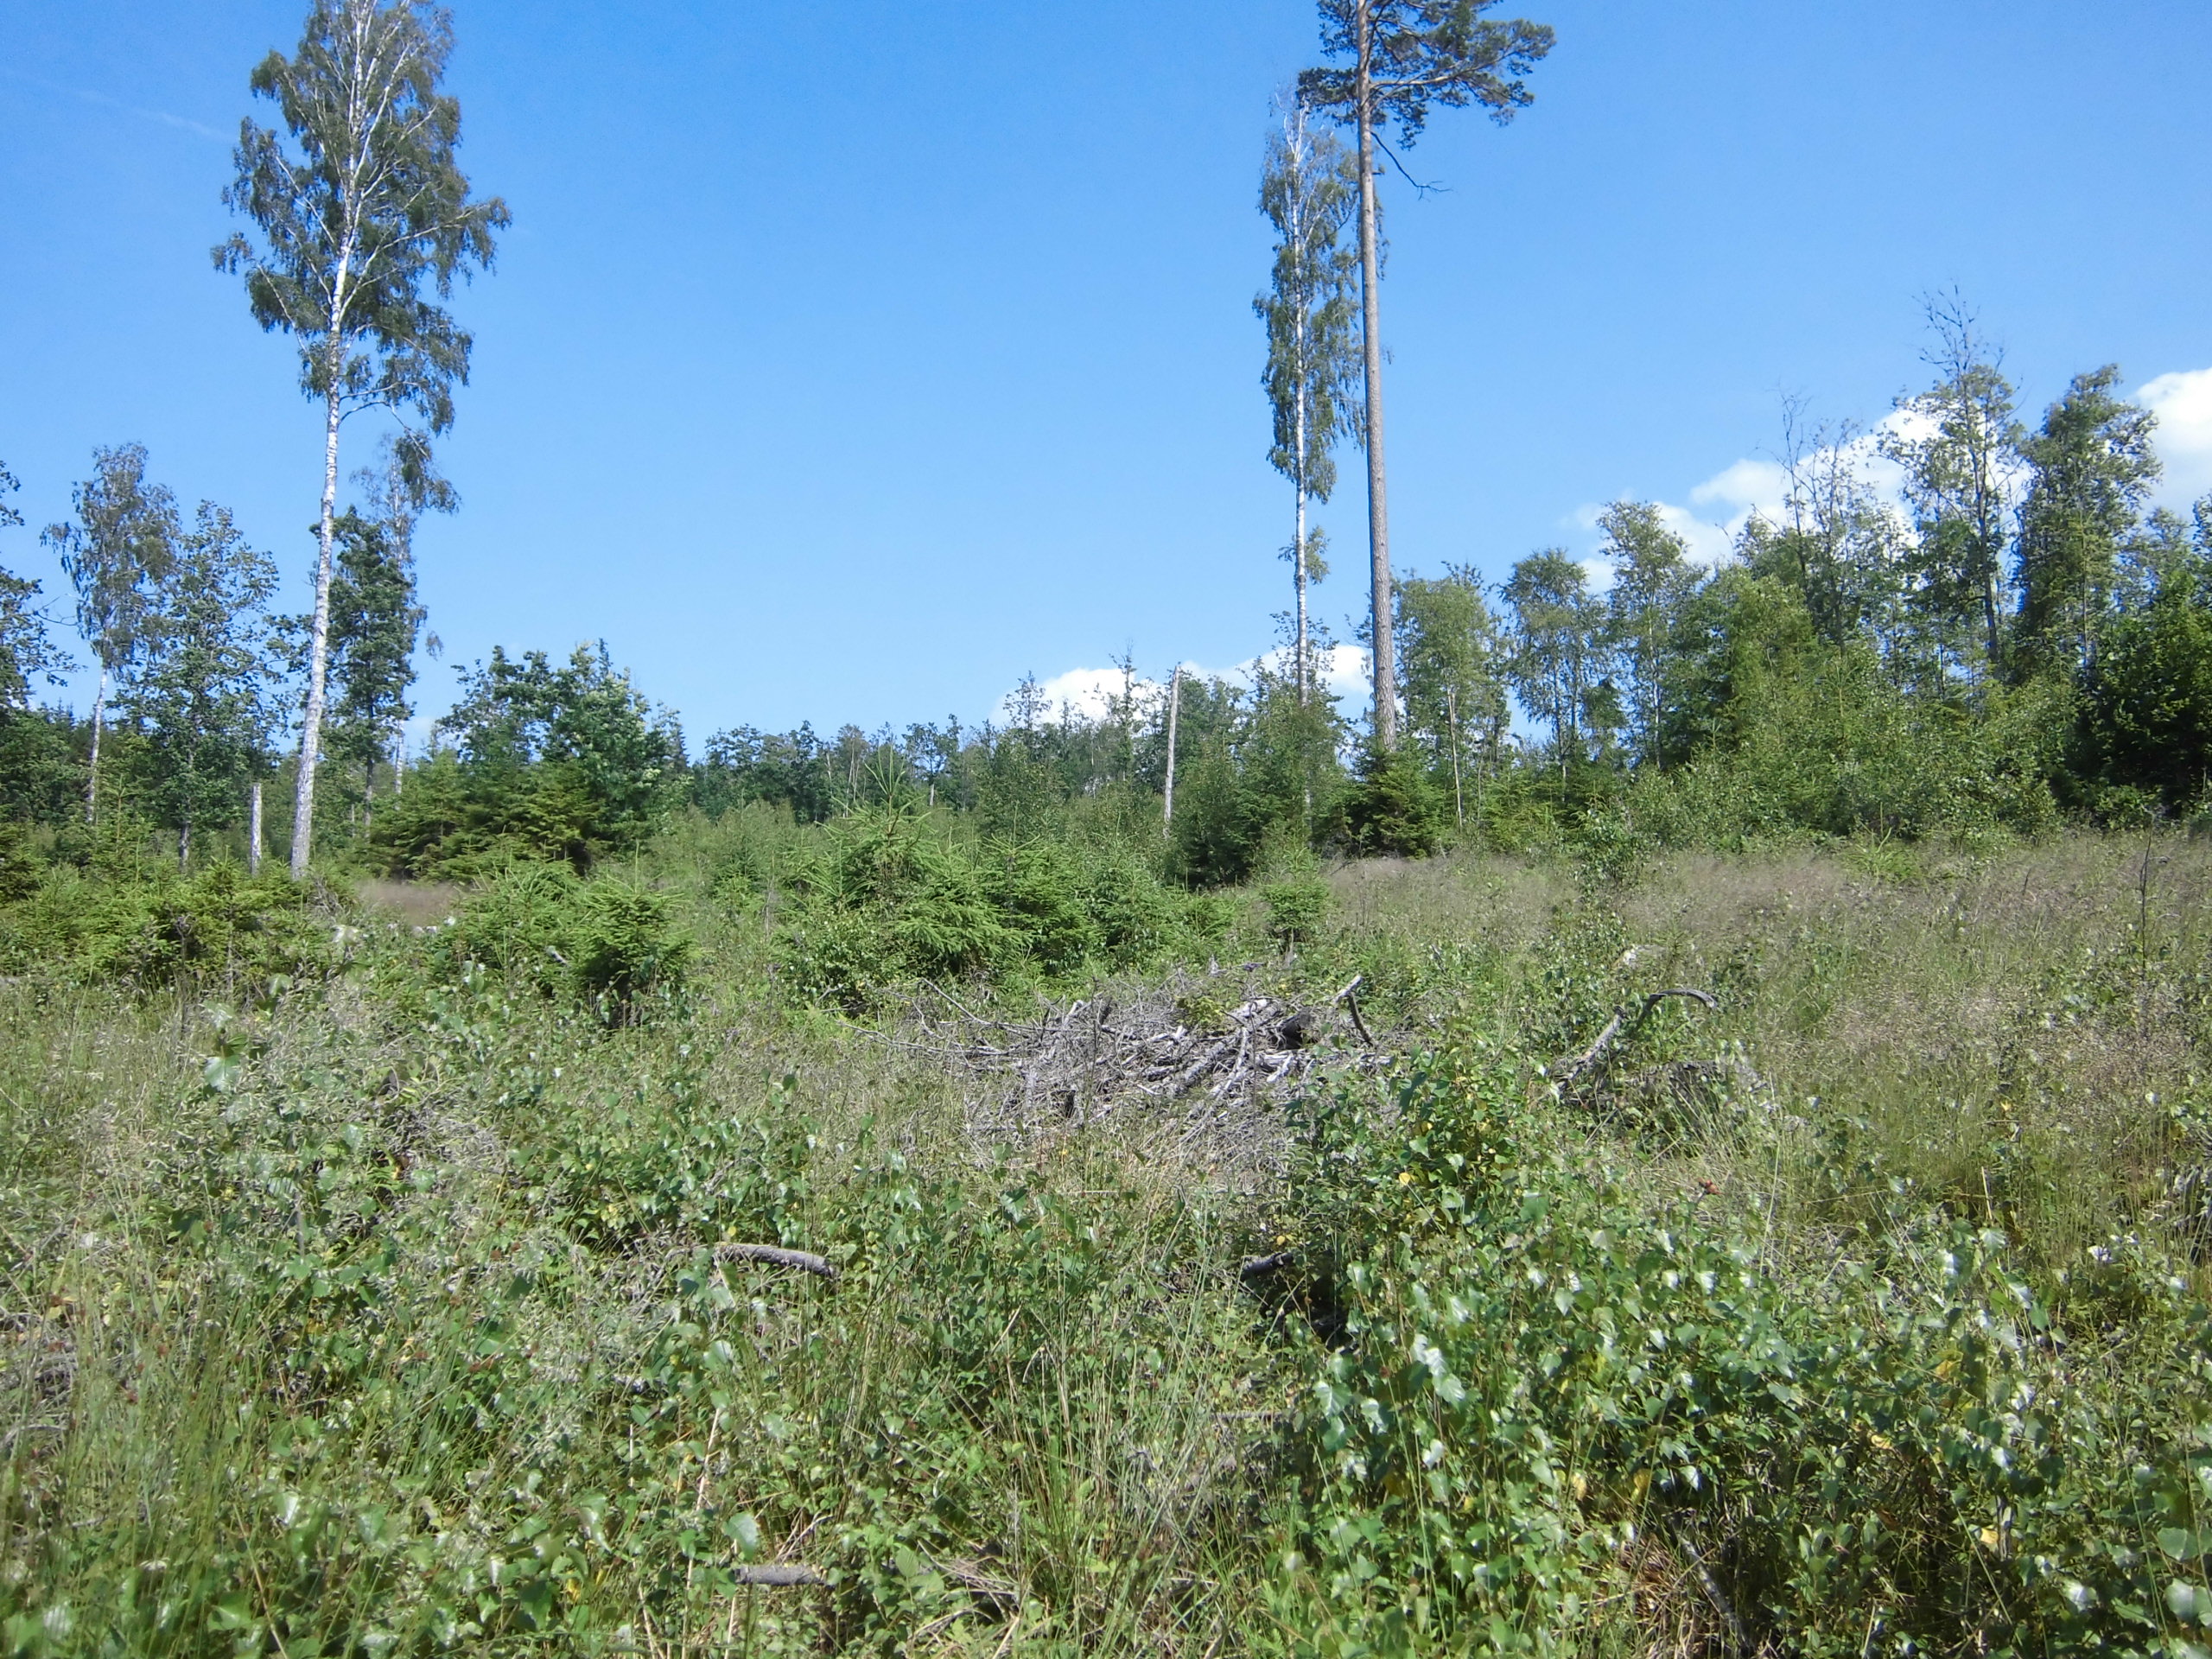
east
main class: Woodland
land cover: Spruce dominated mixed woodland
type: boreal forest
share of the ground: 25 - 50 %
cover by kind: coniferous forest trees 25 %, broadleaved forest trees 25 %, shrubs 25 %, herbaceous plants 15 %, lichens and mosses 10 %
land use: Forestry
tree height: < 5 m
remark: Clear cut
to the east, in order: Spruce dominated mixed woodland; Tracks; Broadleaved woodland; Spruce dominated mixed woodland
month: July
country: SE
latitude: 57.2652
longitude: 14.3900
